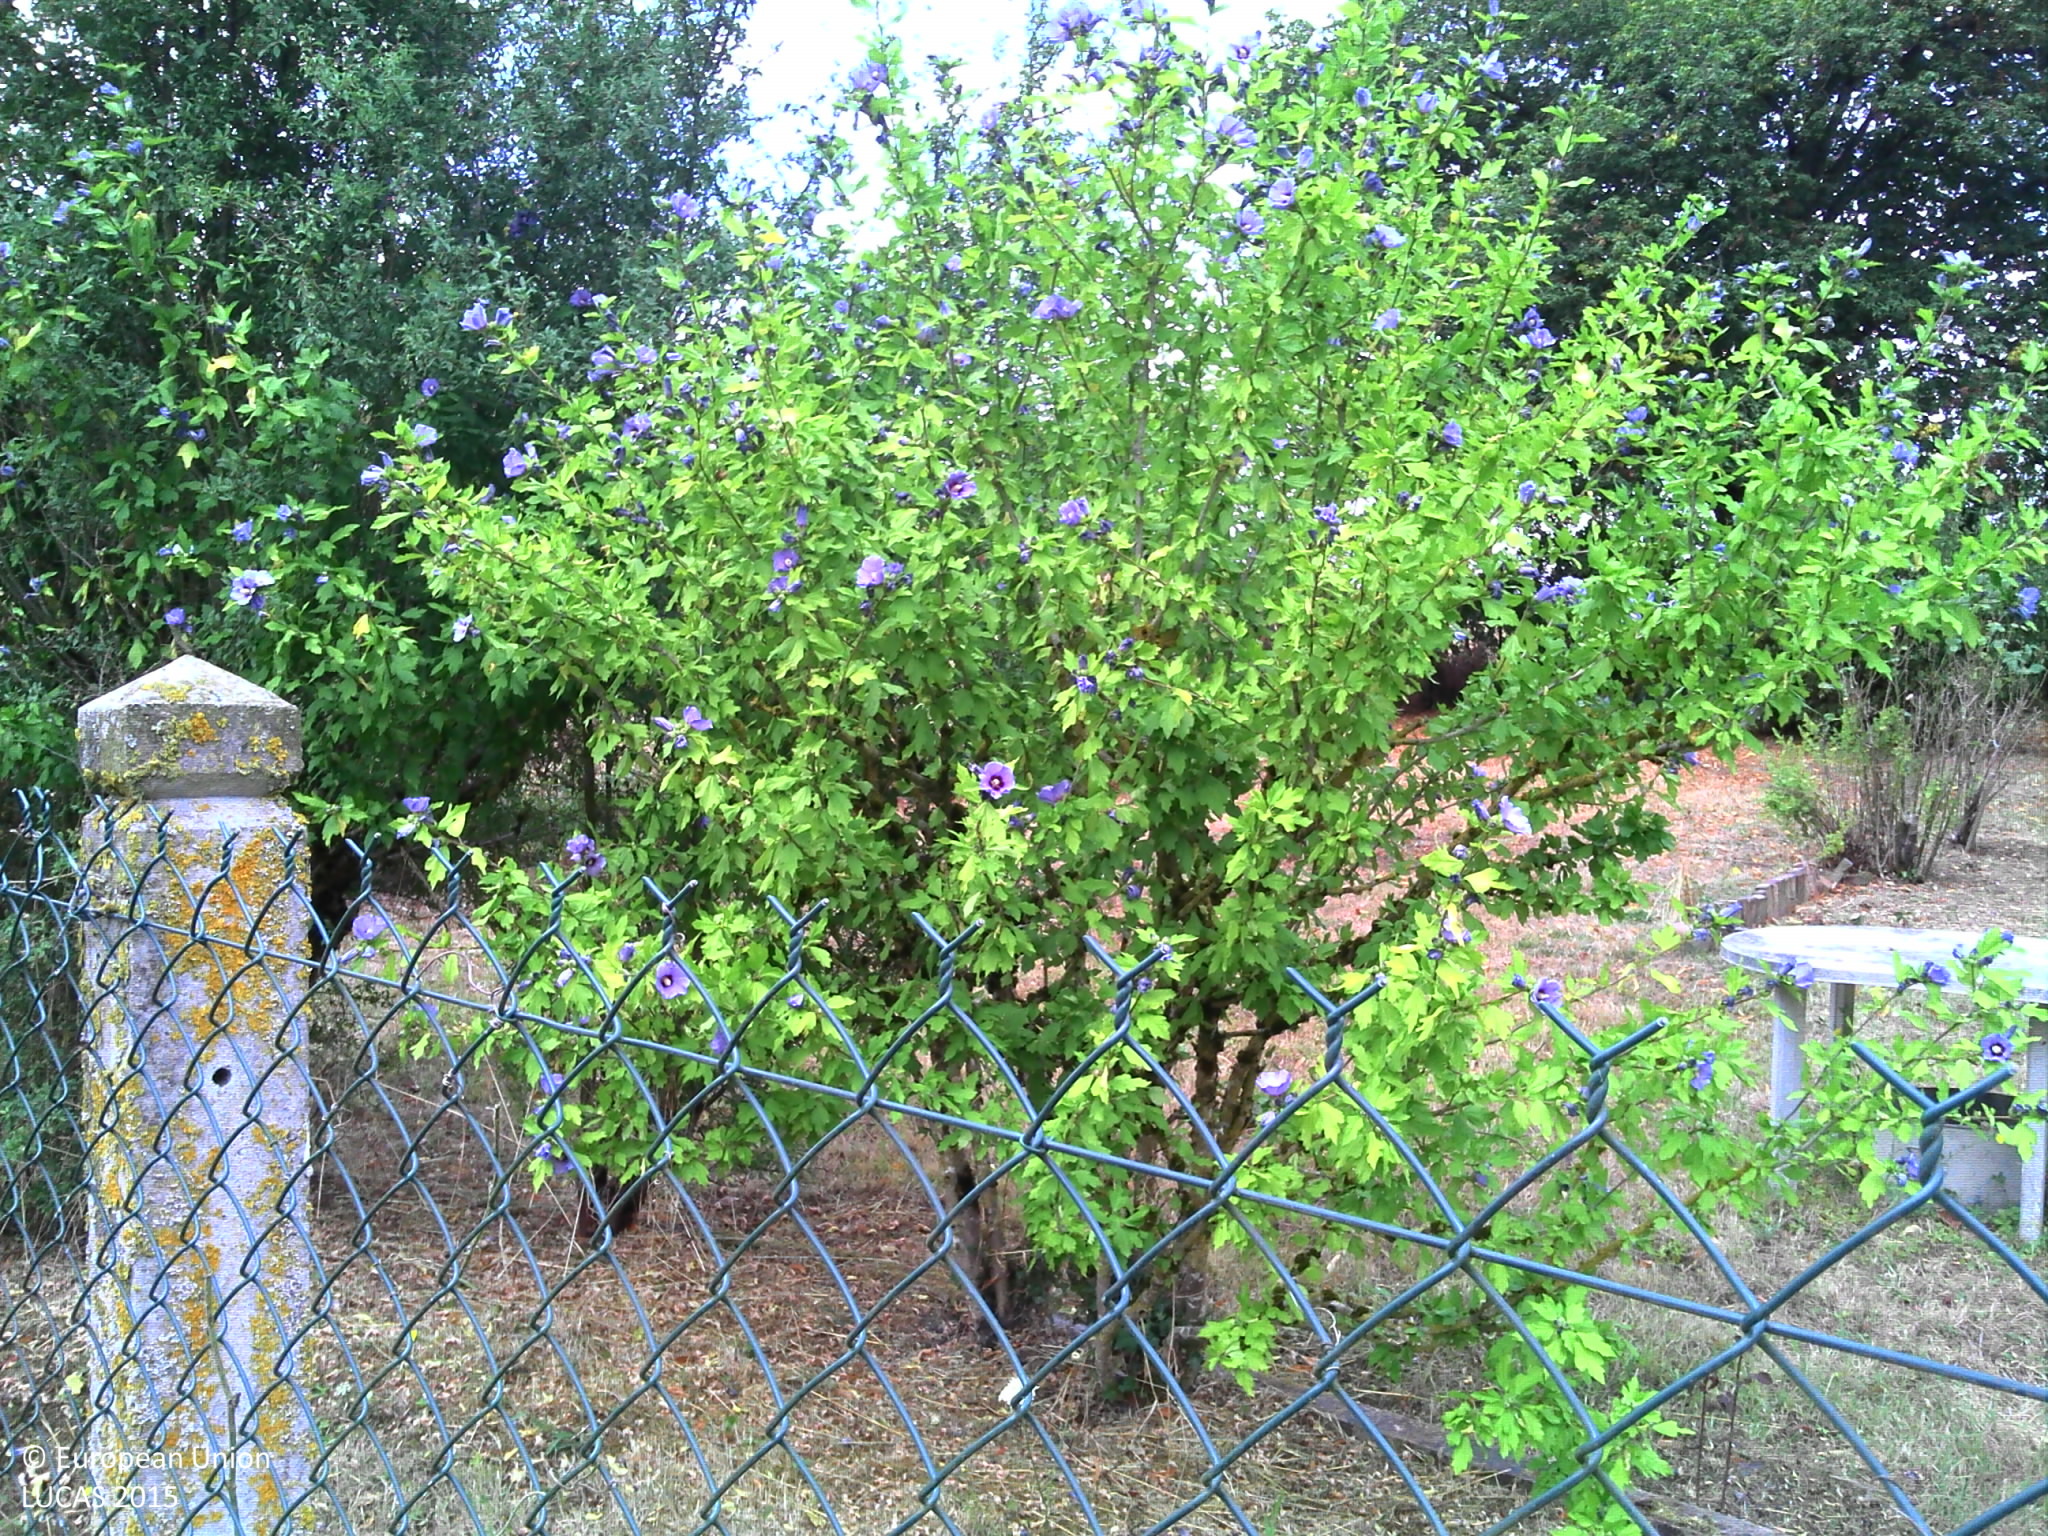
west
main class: Grassland
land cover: Grassland with sparse tree/shrub cover
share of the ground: > 75 %
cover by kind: herbaceous plants 90 %, broadleaved forest trees 5 %, shrubs 5 %
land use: Amenities, museums, leisure
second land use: Residential
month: July
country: FR
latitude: 48.0801
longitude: 3.4036
